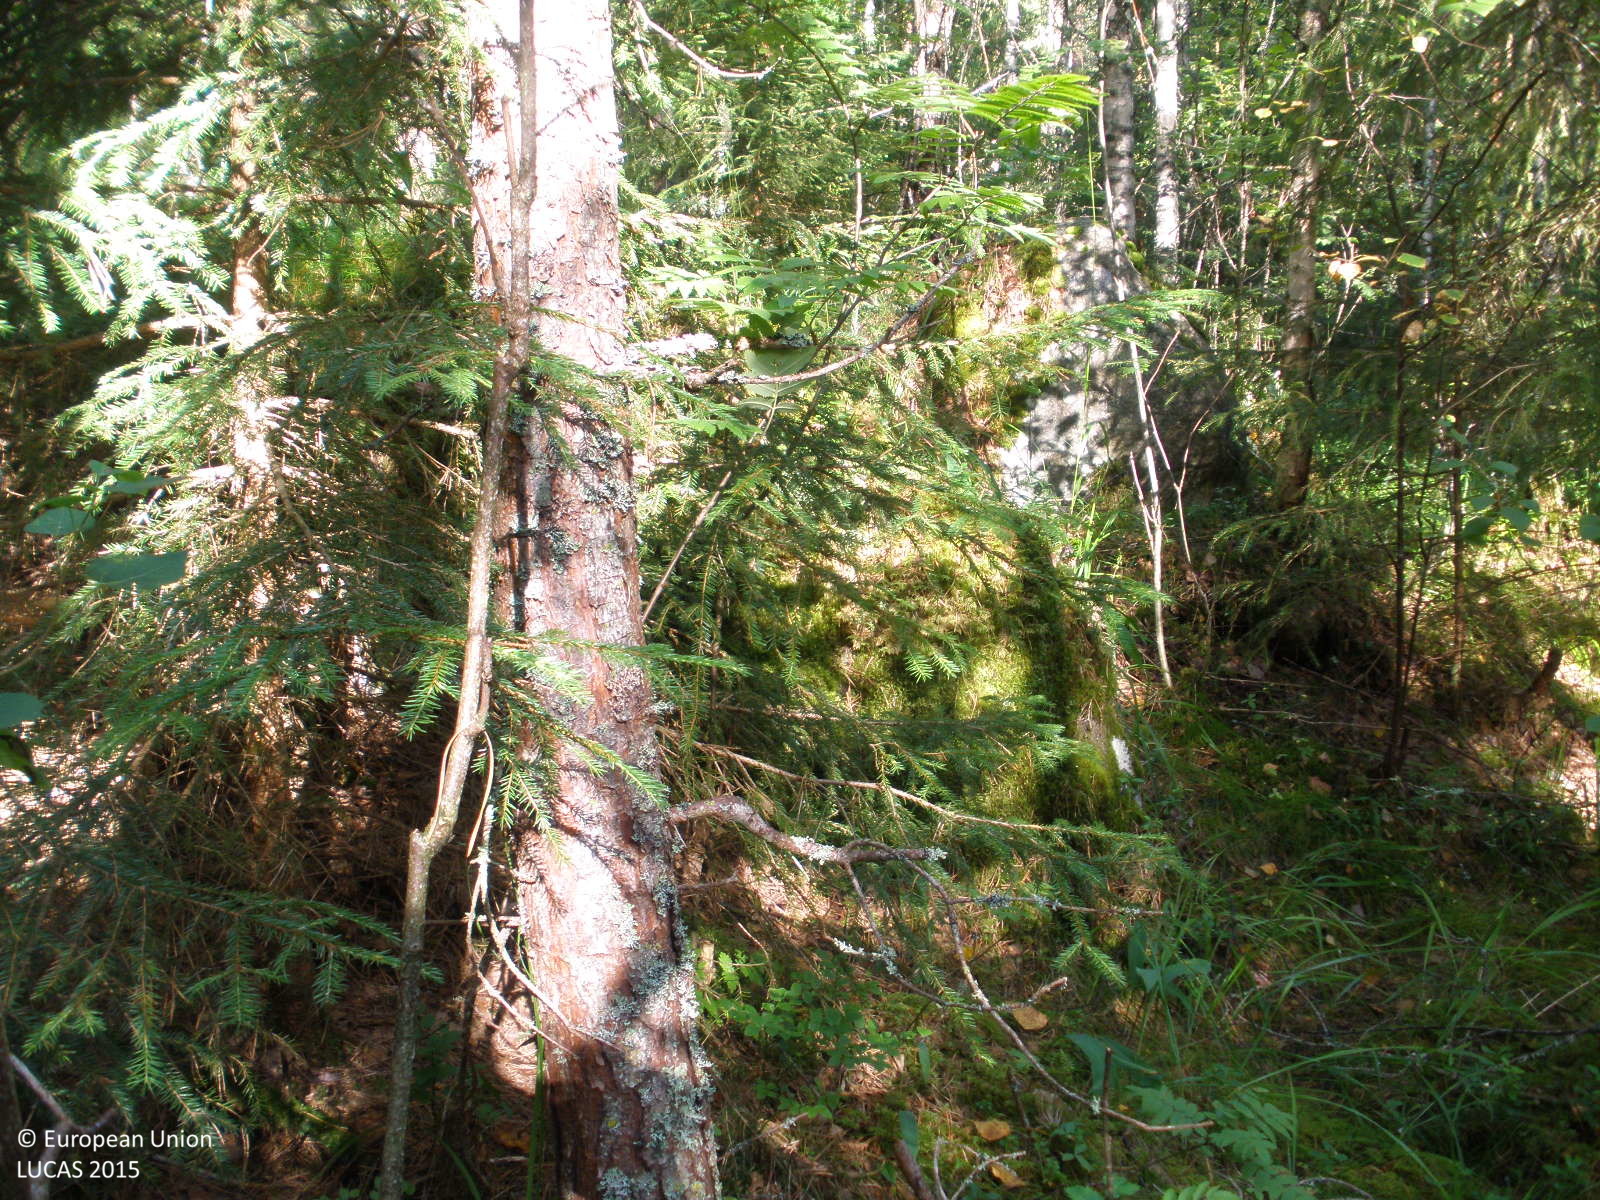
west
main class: Woodland
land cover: Pine dominated mixed woodland
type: boreal forest
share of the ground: > 75 %
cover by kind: coniferous forest trees 60 %, broadleaved forest trees 25 %, lichens and mosses 10 %, herbaceous plants 5 %
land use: Forestry
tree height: > 5 m
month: August
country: FI
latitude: 60.9138
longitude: 24.8450
